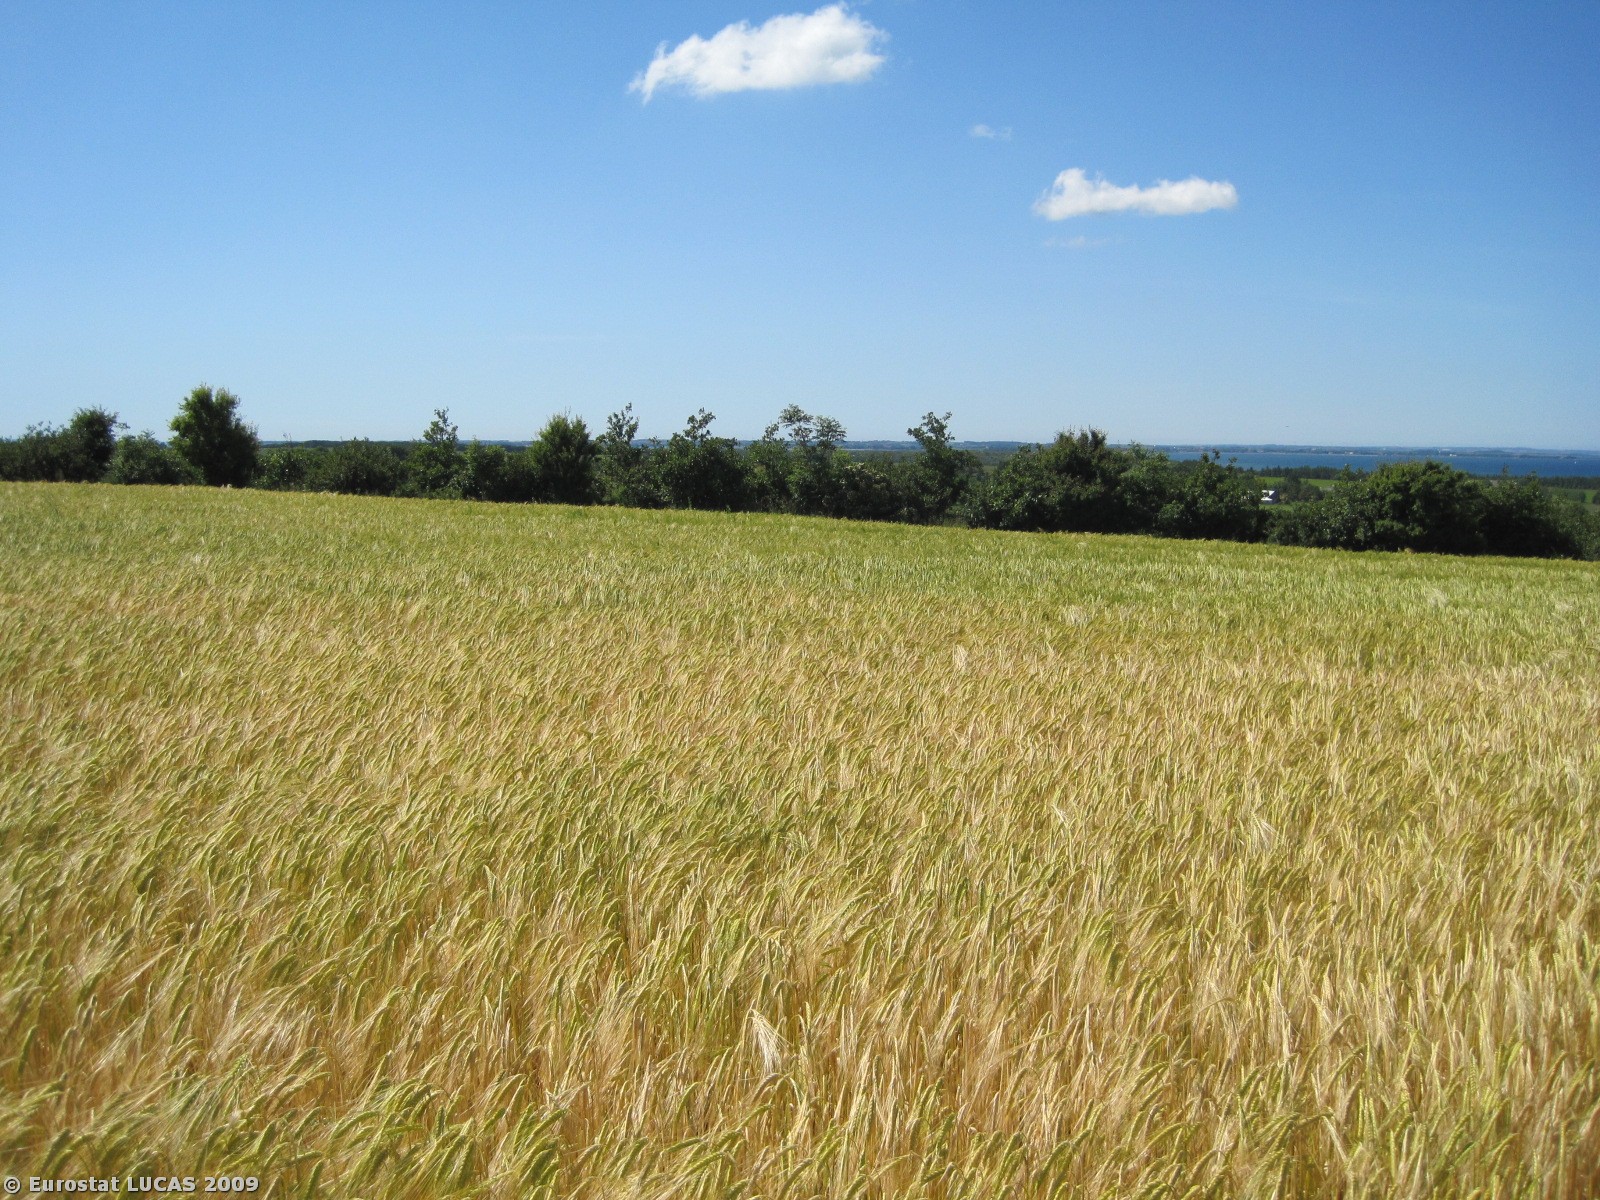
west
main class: Cropland
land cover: Barley
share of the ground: > 75 %
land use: Agriculture (excluding fallow land and kitchen gardens)
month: June
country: DK
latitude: 56.6131
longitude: 8.7470
